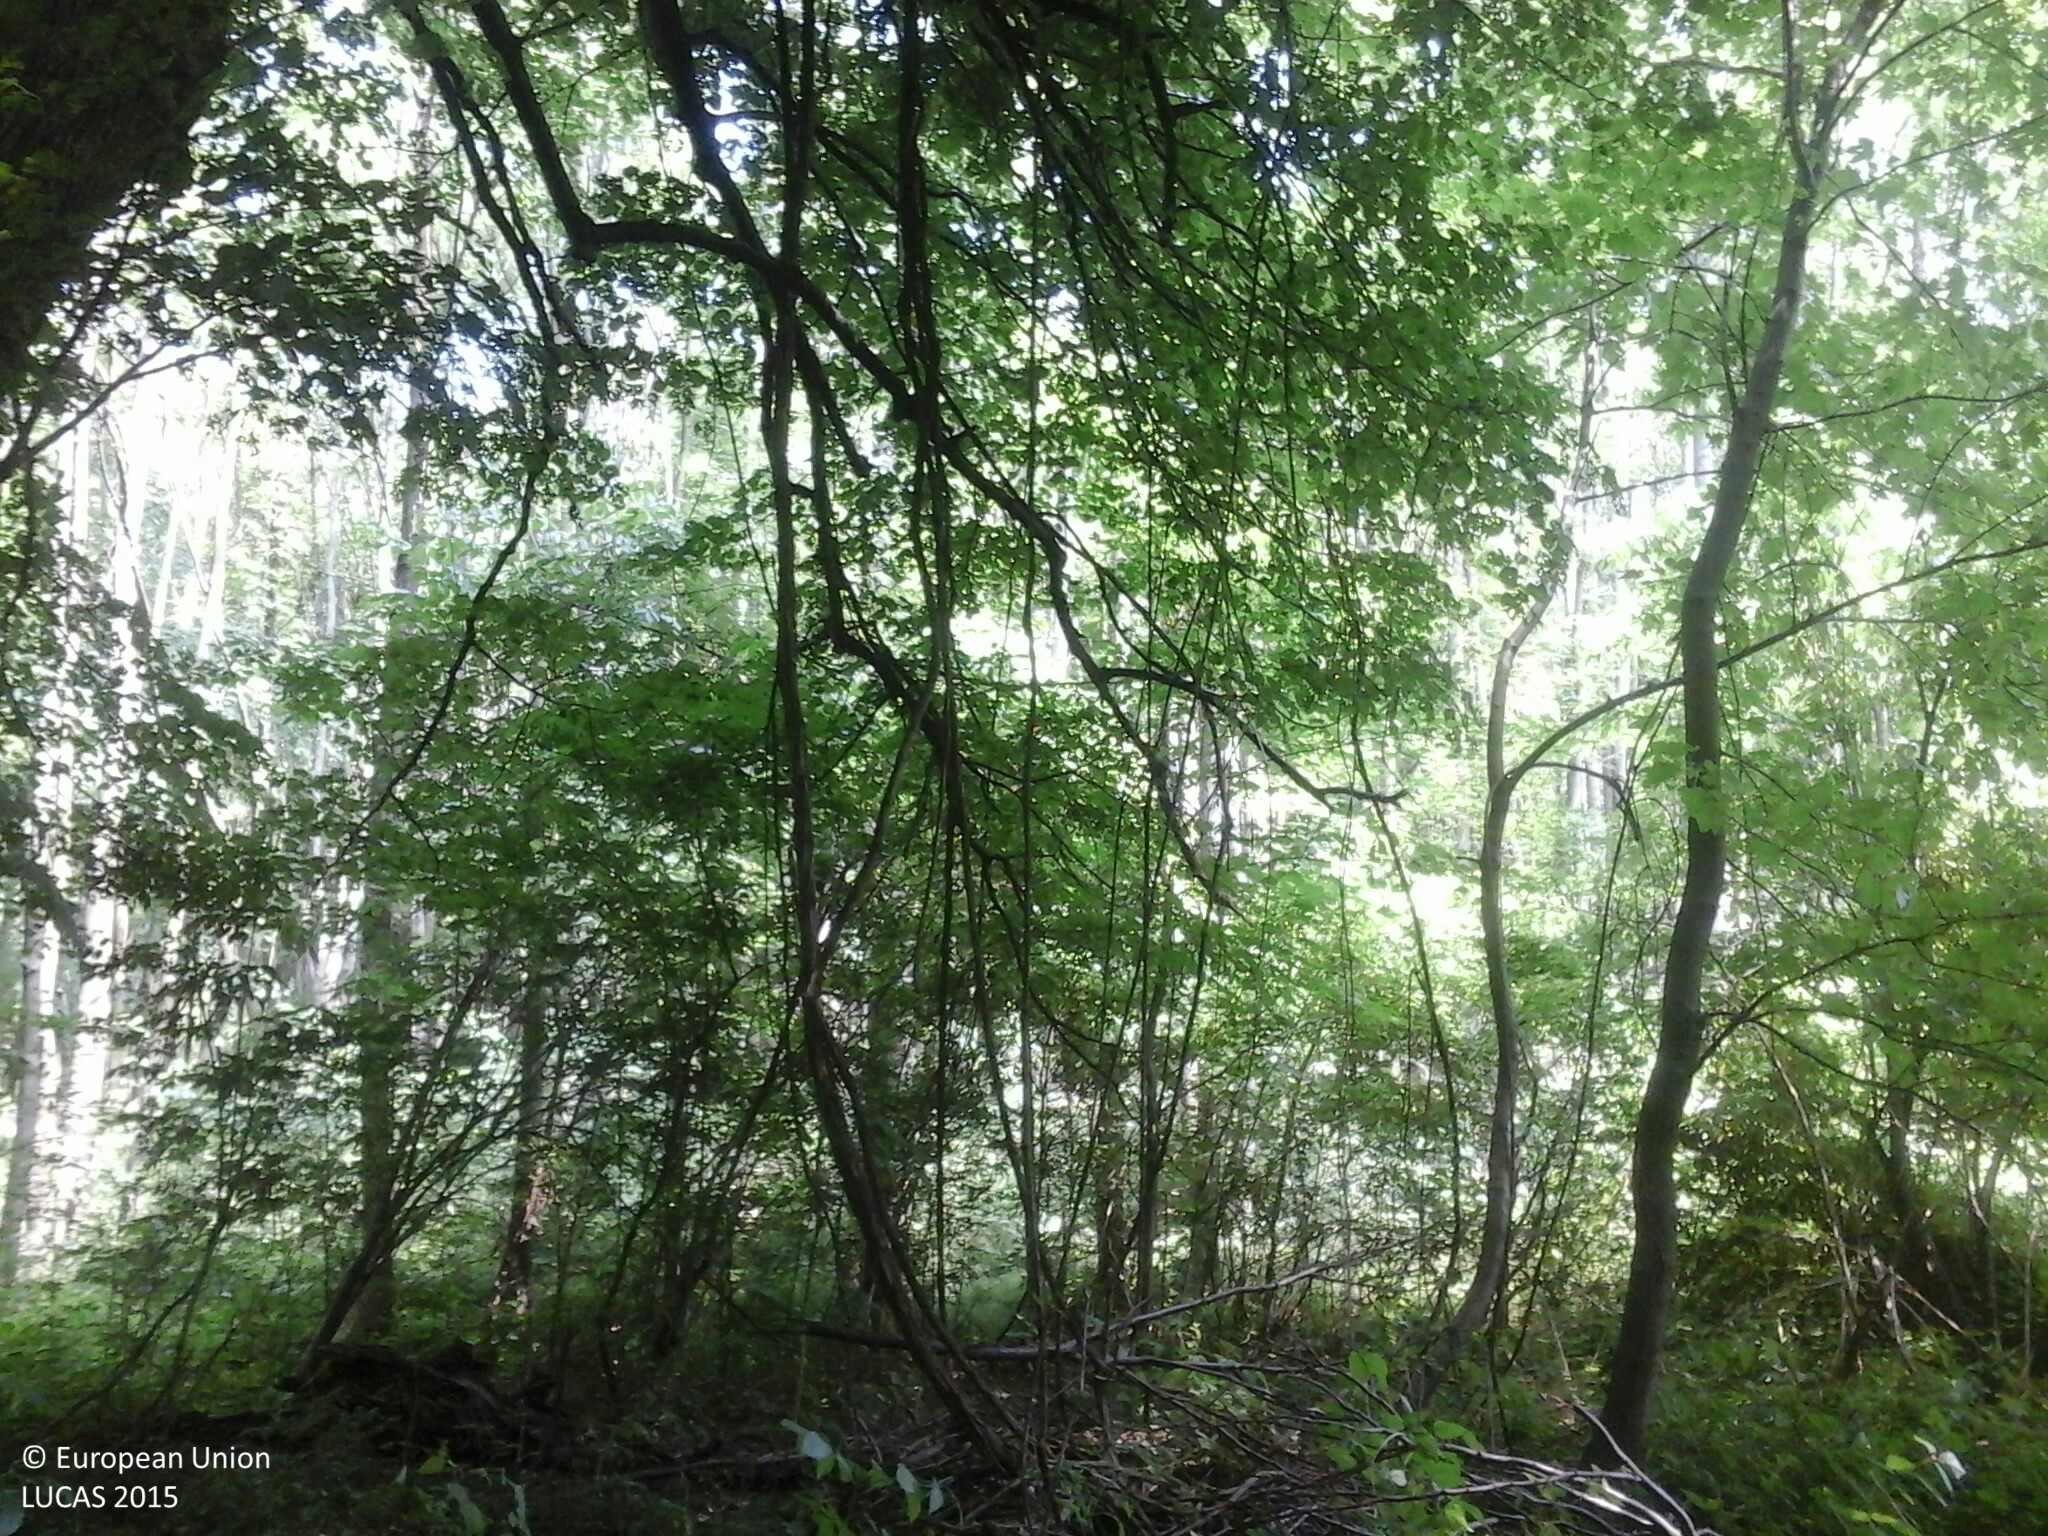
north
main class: Woodland
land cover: Broadleaved woodland
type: beech forest
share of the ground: > 75 %
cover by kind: broadleaved forest trees 95 %, unconsolidated bare surface 5 %
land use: Forestry
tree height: > 5 m
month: July
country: HU
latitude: 47.2406
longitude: 17.8163
